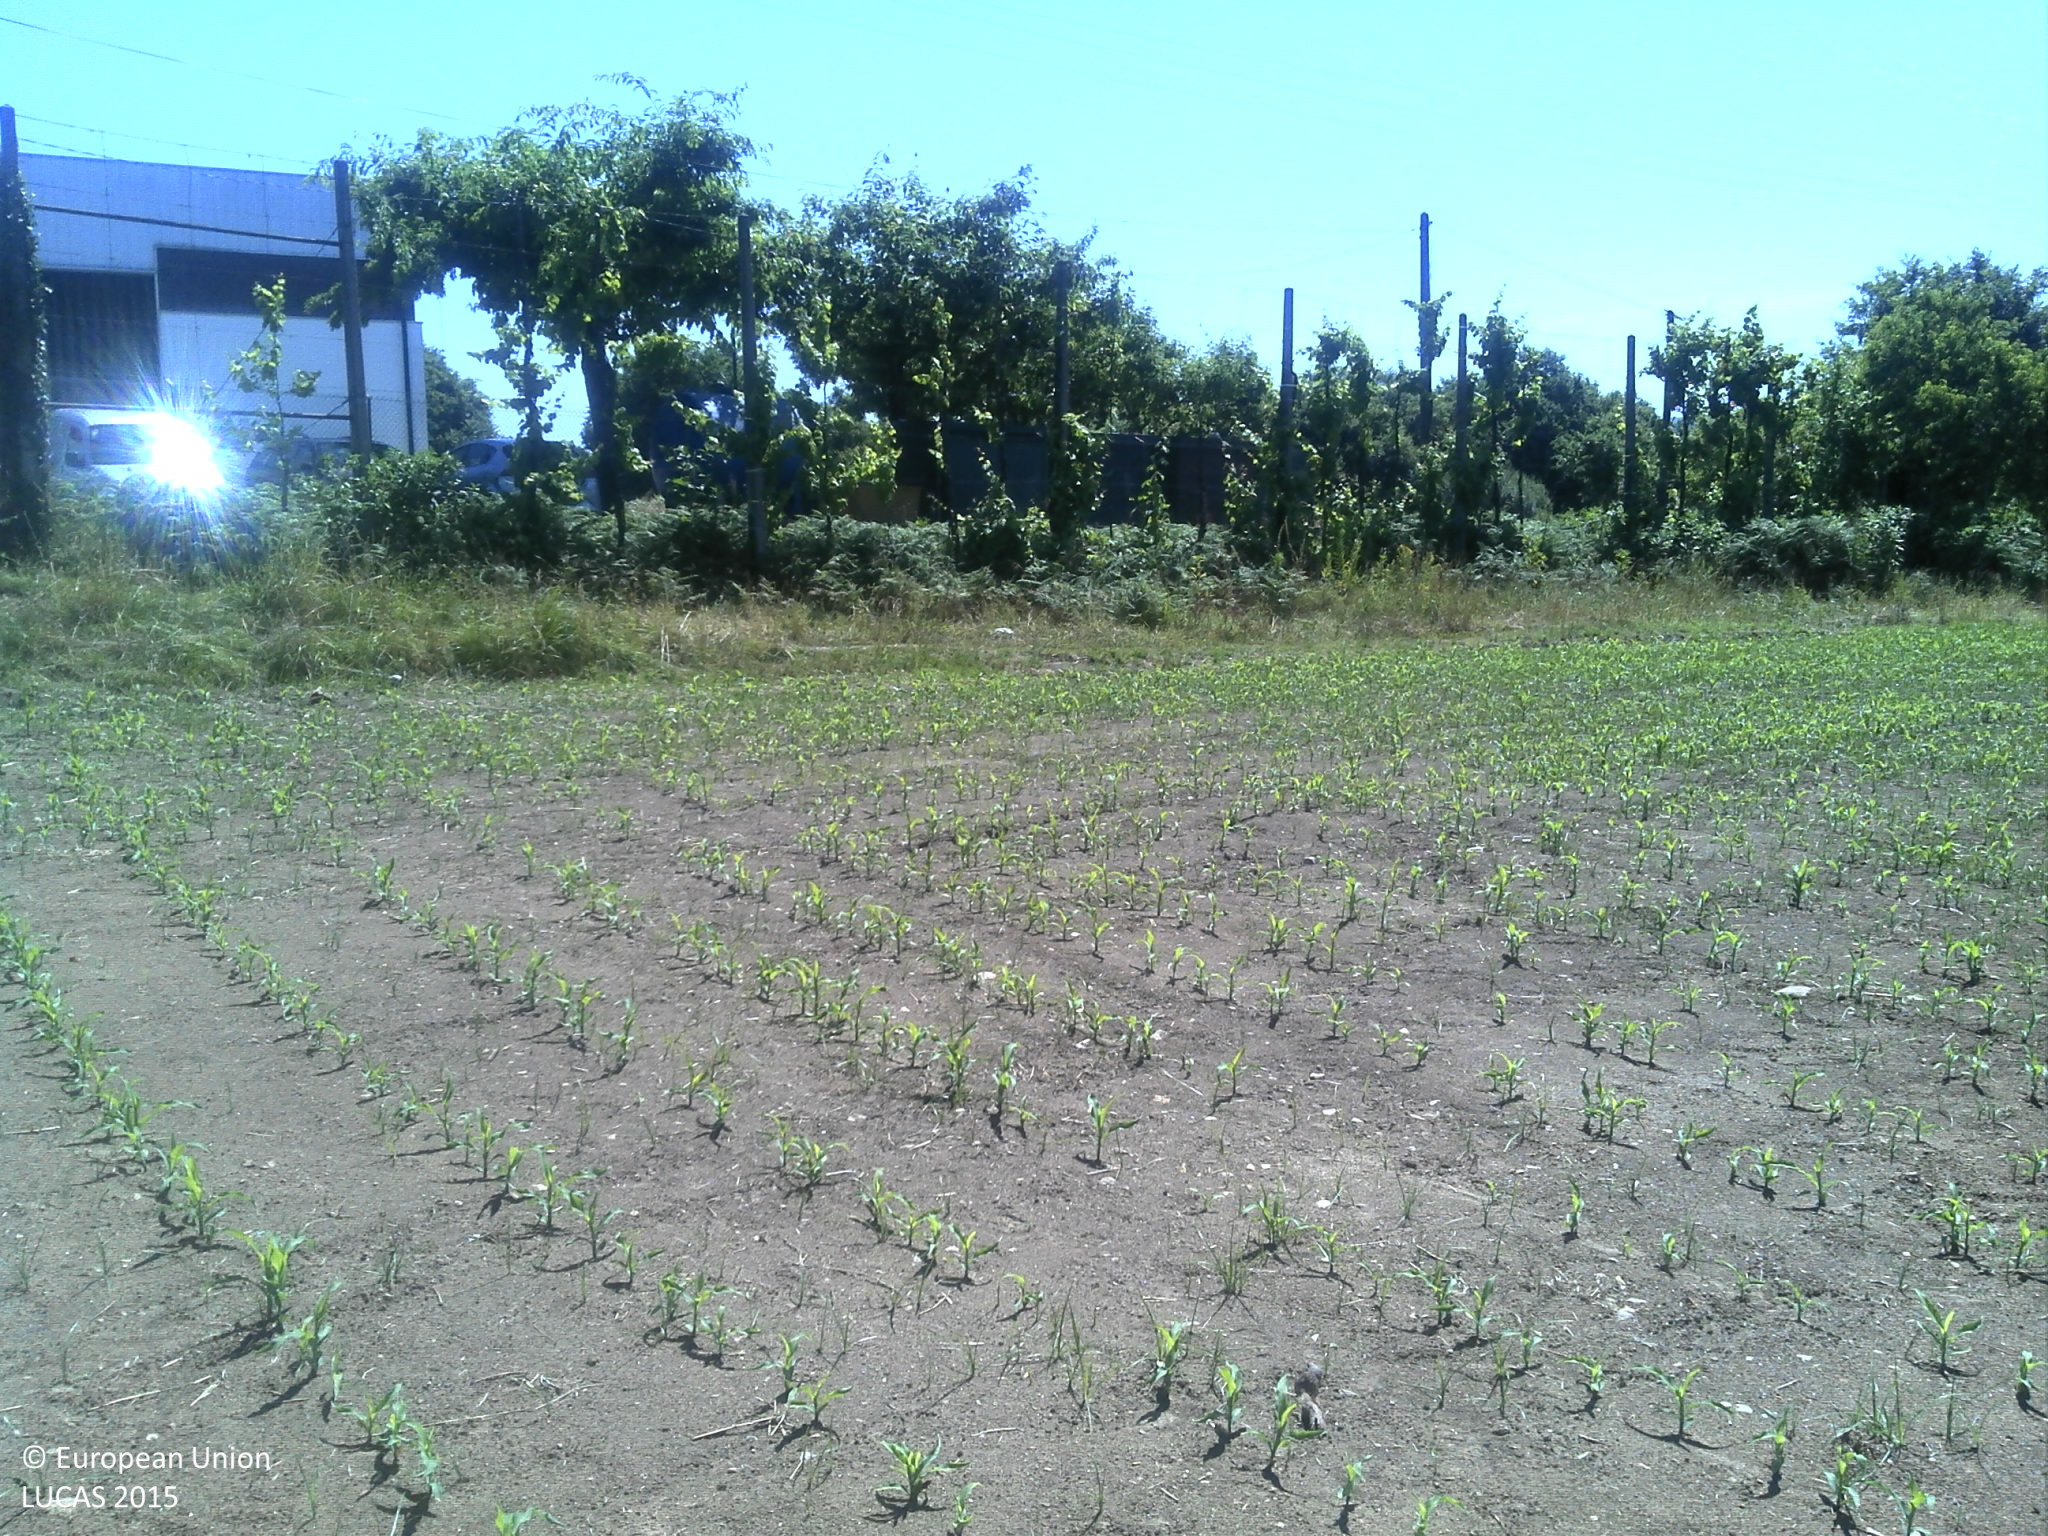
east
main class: Cropland
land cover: Maize
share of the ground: 10 - 25 %
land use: Agriculture (excluding fallow land and kitchen gardens)
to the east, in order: Maize; Electric lines; Vineyards; Tracks; Dry stone walls; Artificial constructions in urban areas; Grassland without tree/shrub cover; Spontaneously vegetated surfaces; Shrubland without tree cover; Tracks; Broadleaved woodland; Shrubland without tree cover; Shrubland with sparse tree cover; Shrubland without tree cover; Broadleaved woodland
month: June
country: PT
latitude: 41.5187
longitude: -8.3286
